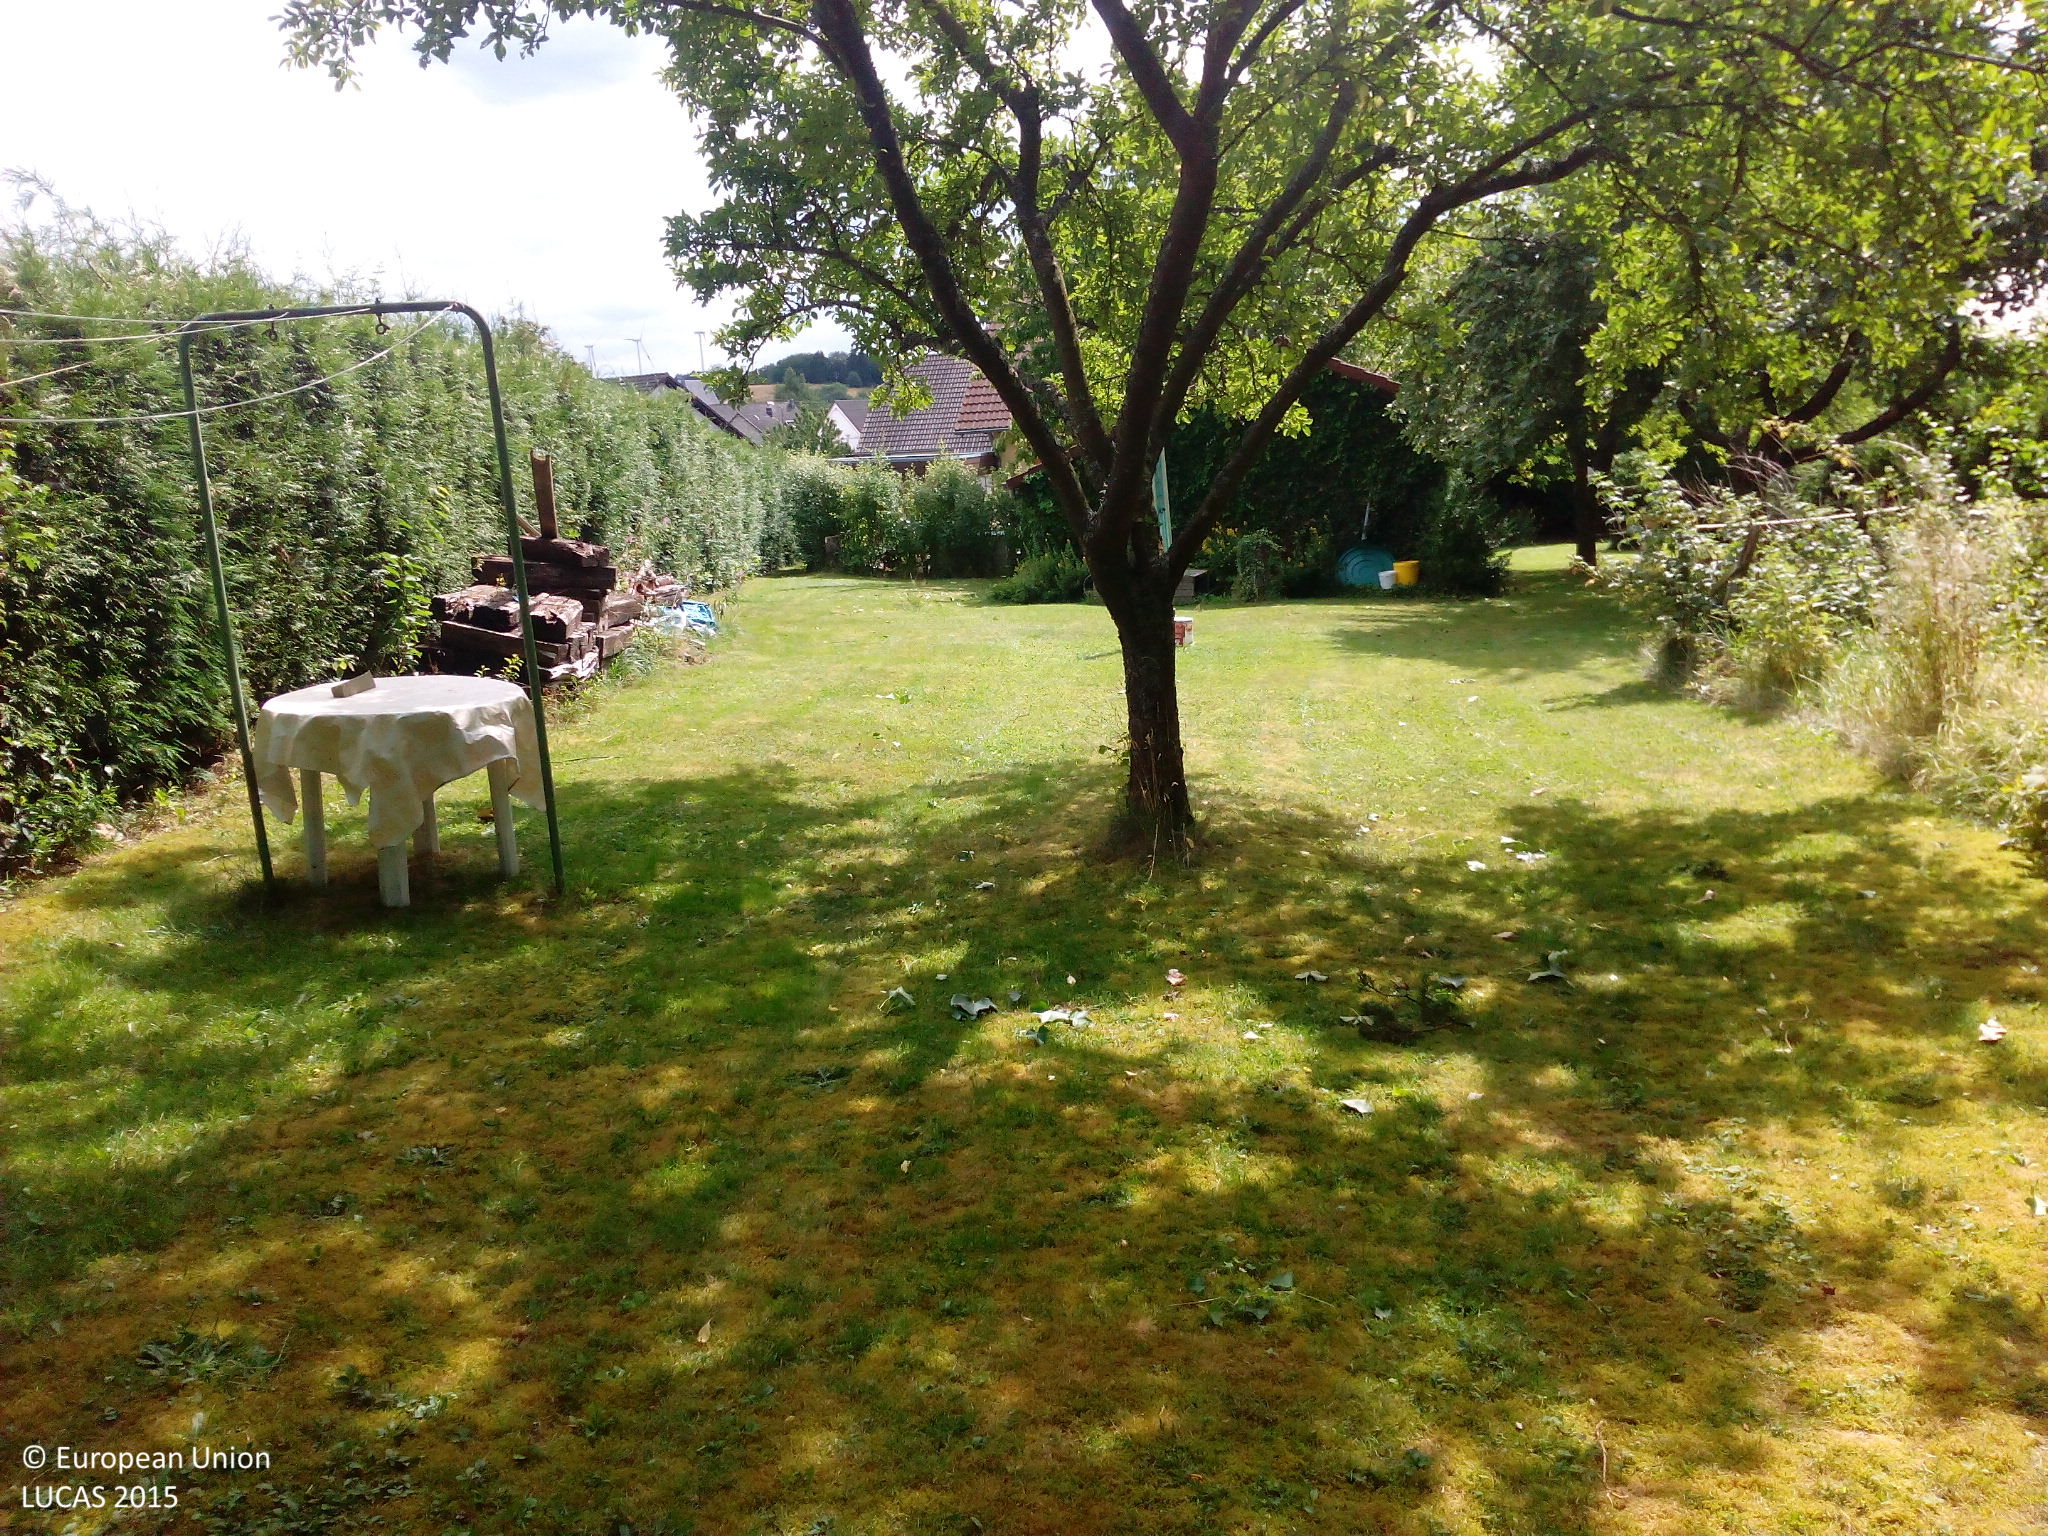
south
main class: Grassland
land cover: Grassland with sparse tree/shrub cover
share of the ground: > 75 %
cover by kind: herbaceous plants 95 %, broadleaved forest trees 5 %
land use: Residential
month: July
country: DE
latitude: 49.8600
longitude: 7.1207
